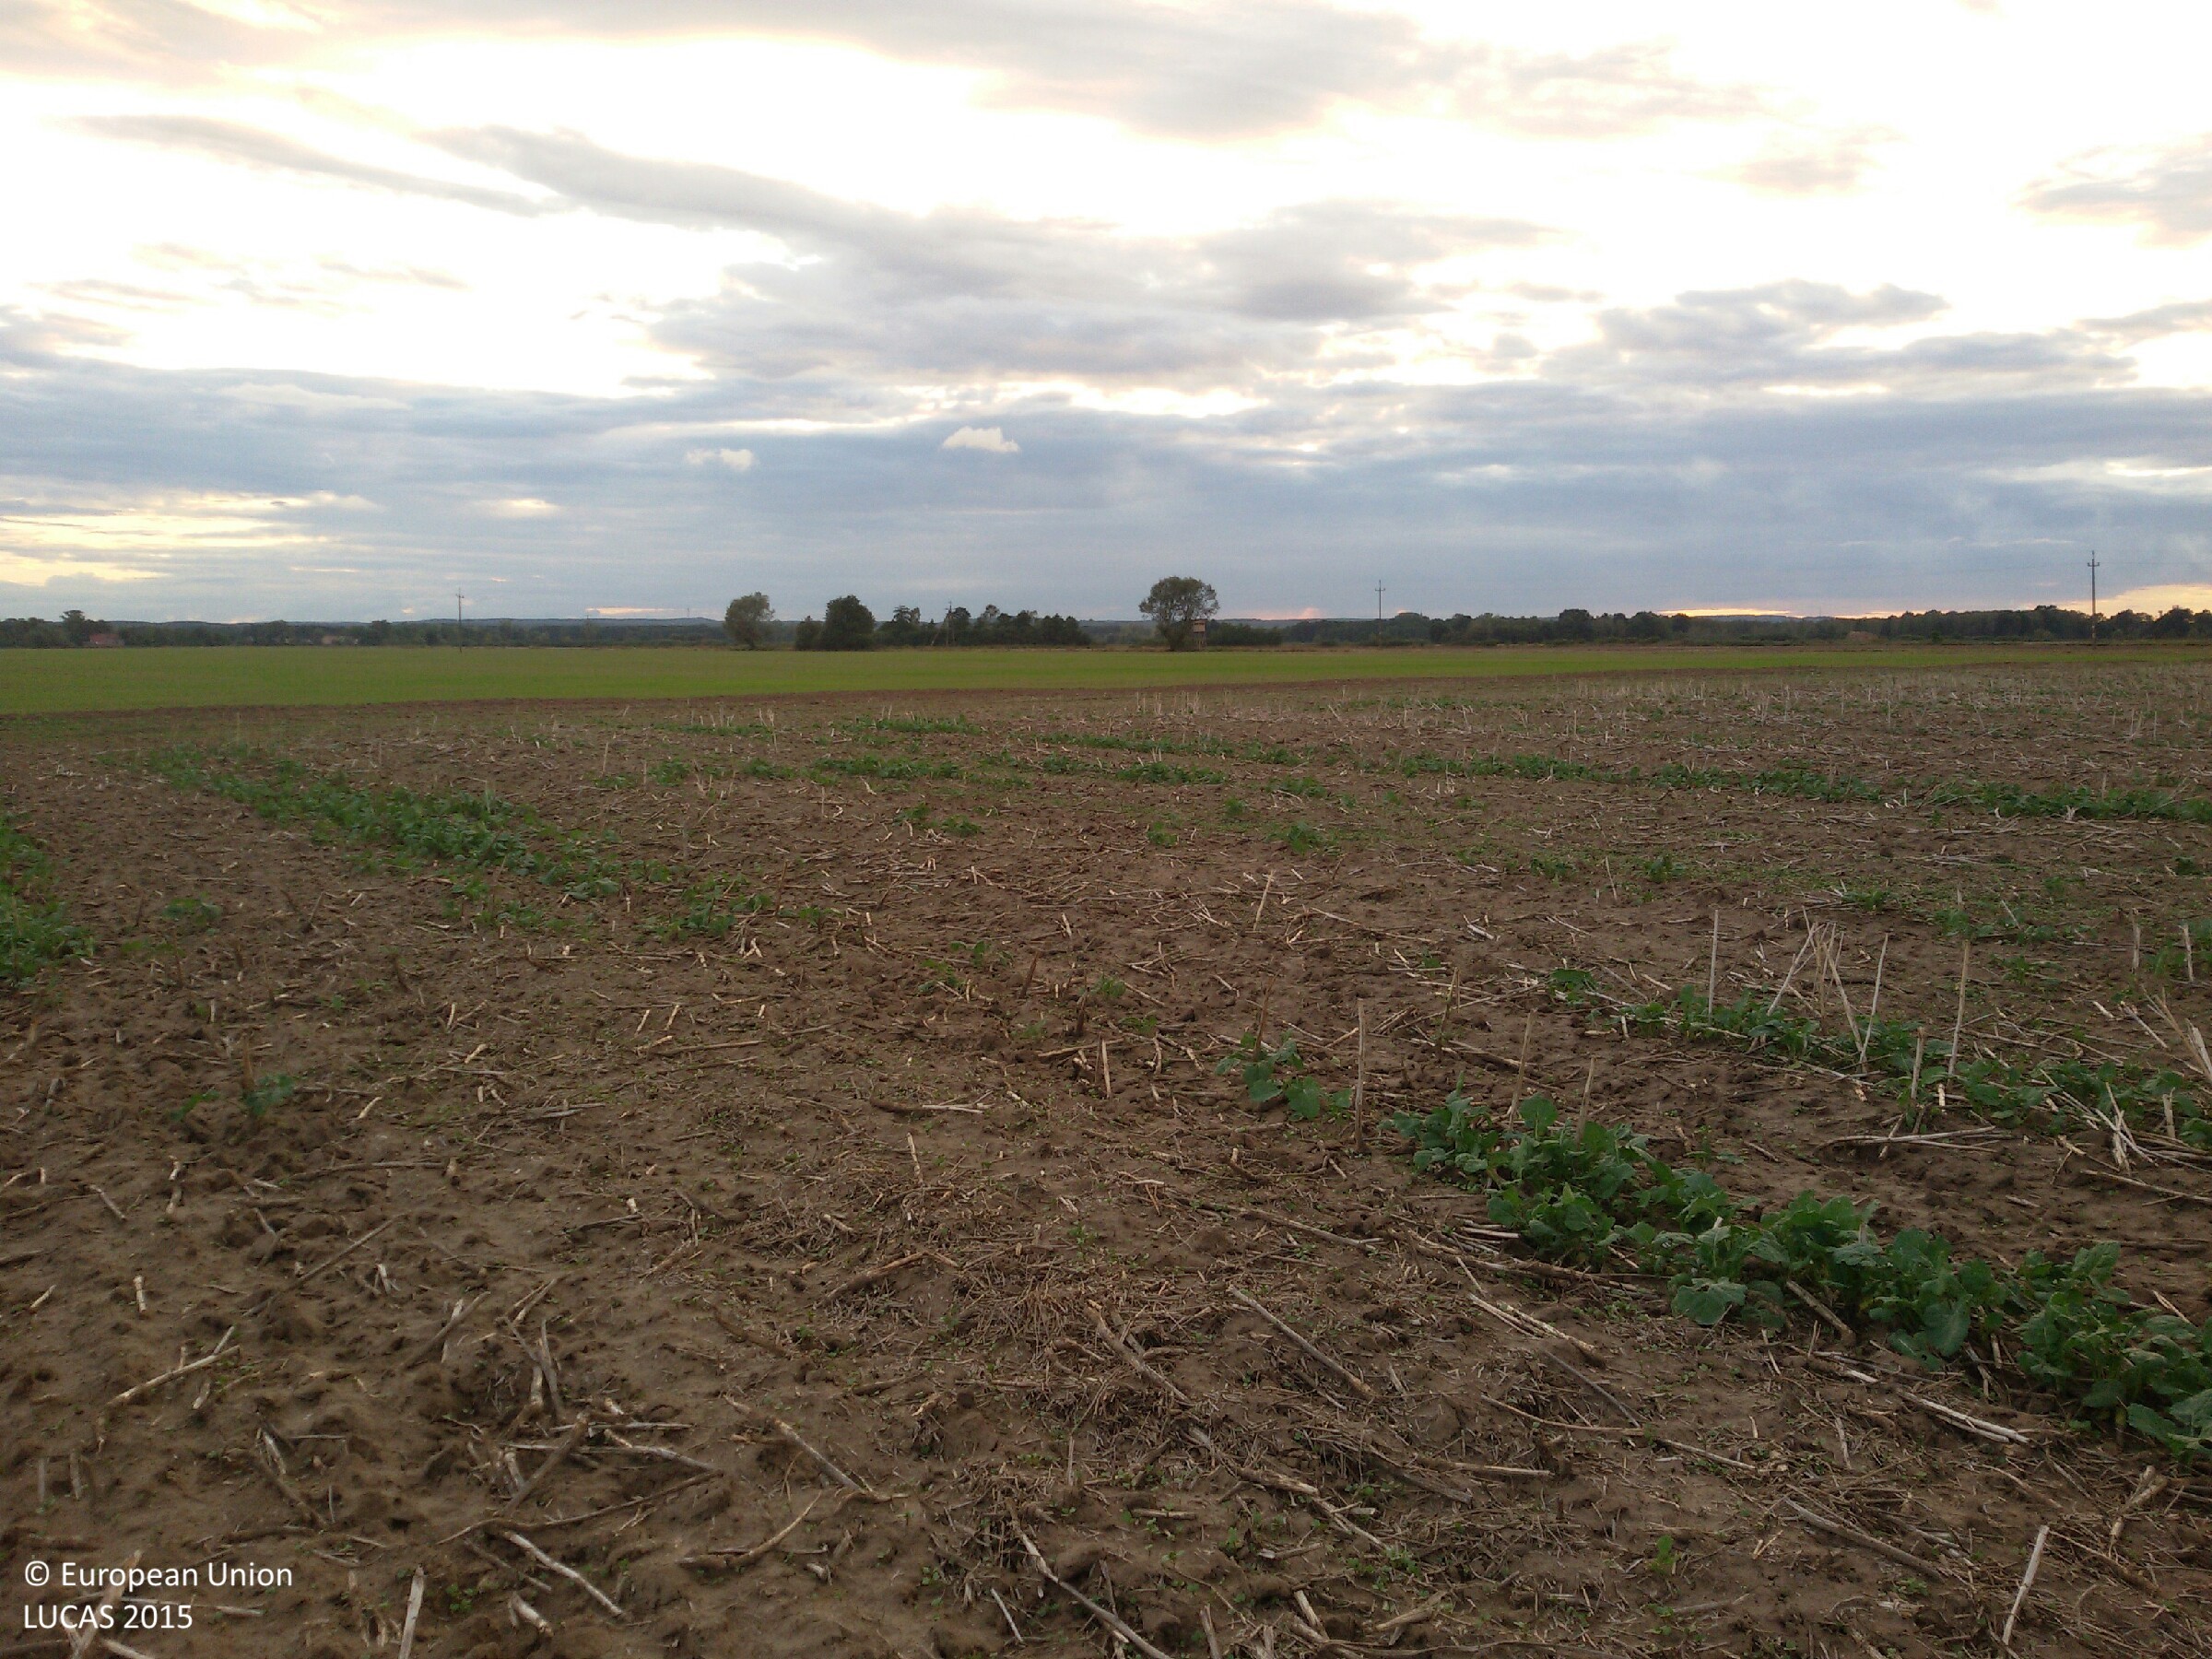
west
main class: Cropland
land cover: Rape and turnip rape
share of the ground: 10 - 25 %
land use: Agriculture (excluding fallow land and kitchen gardens)
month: September
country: PL
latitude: 52.1396
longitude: 14.7216
